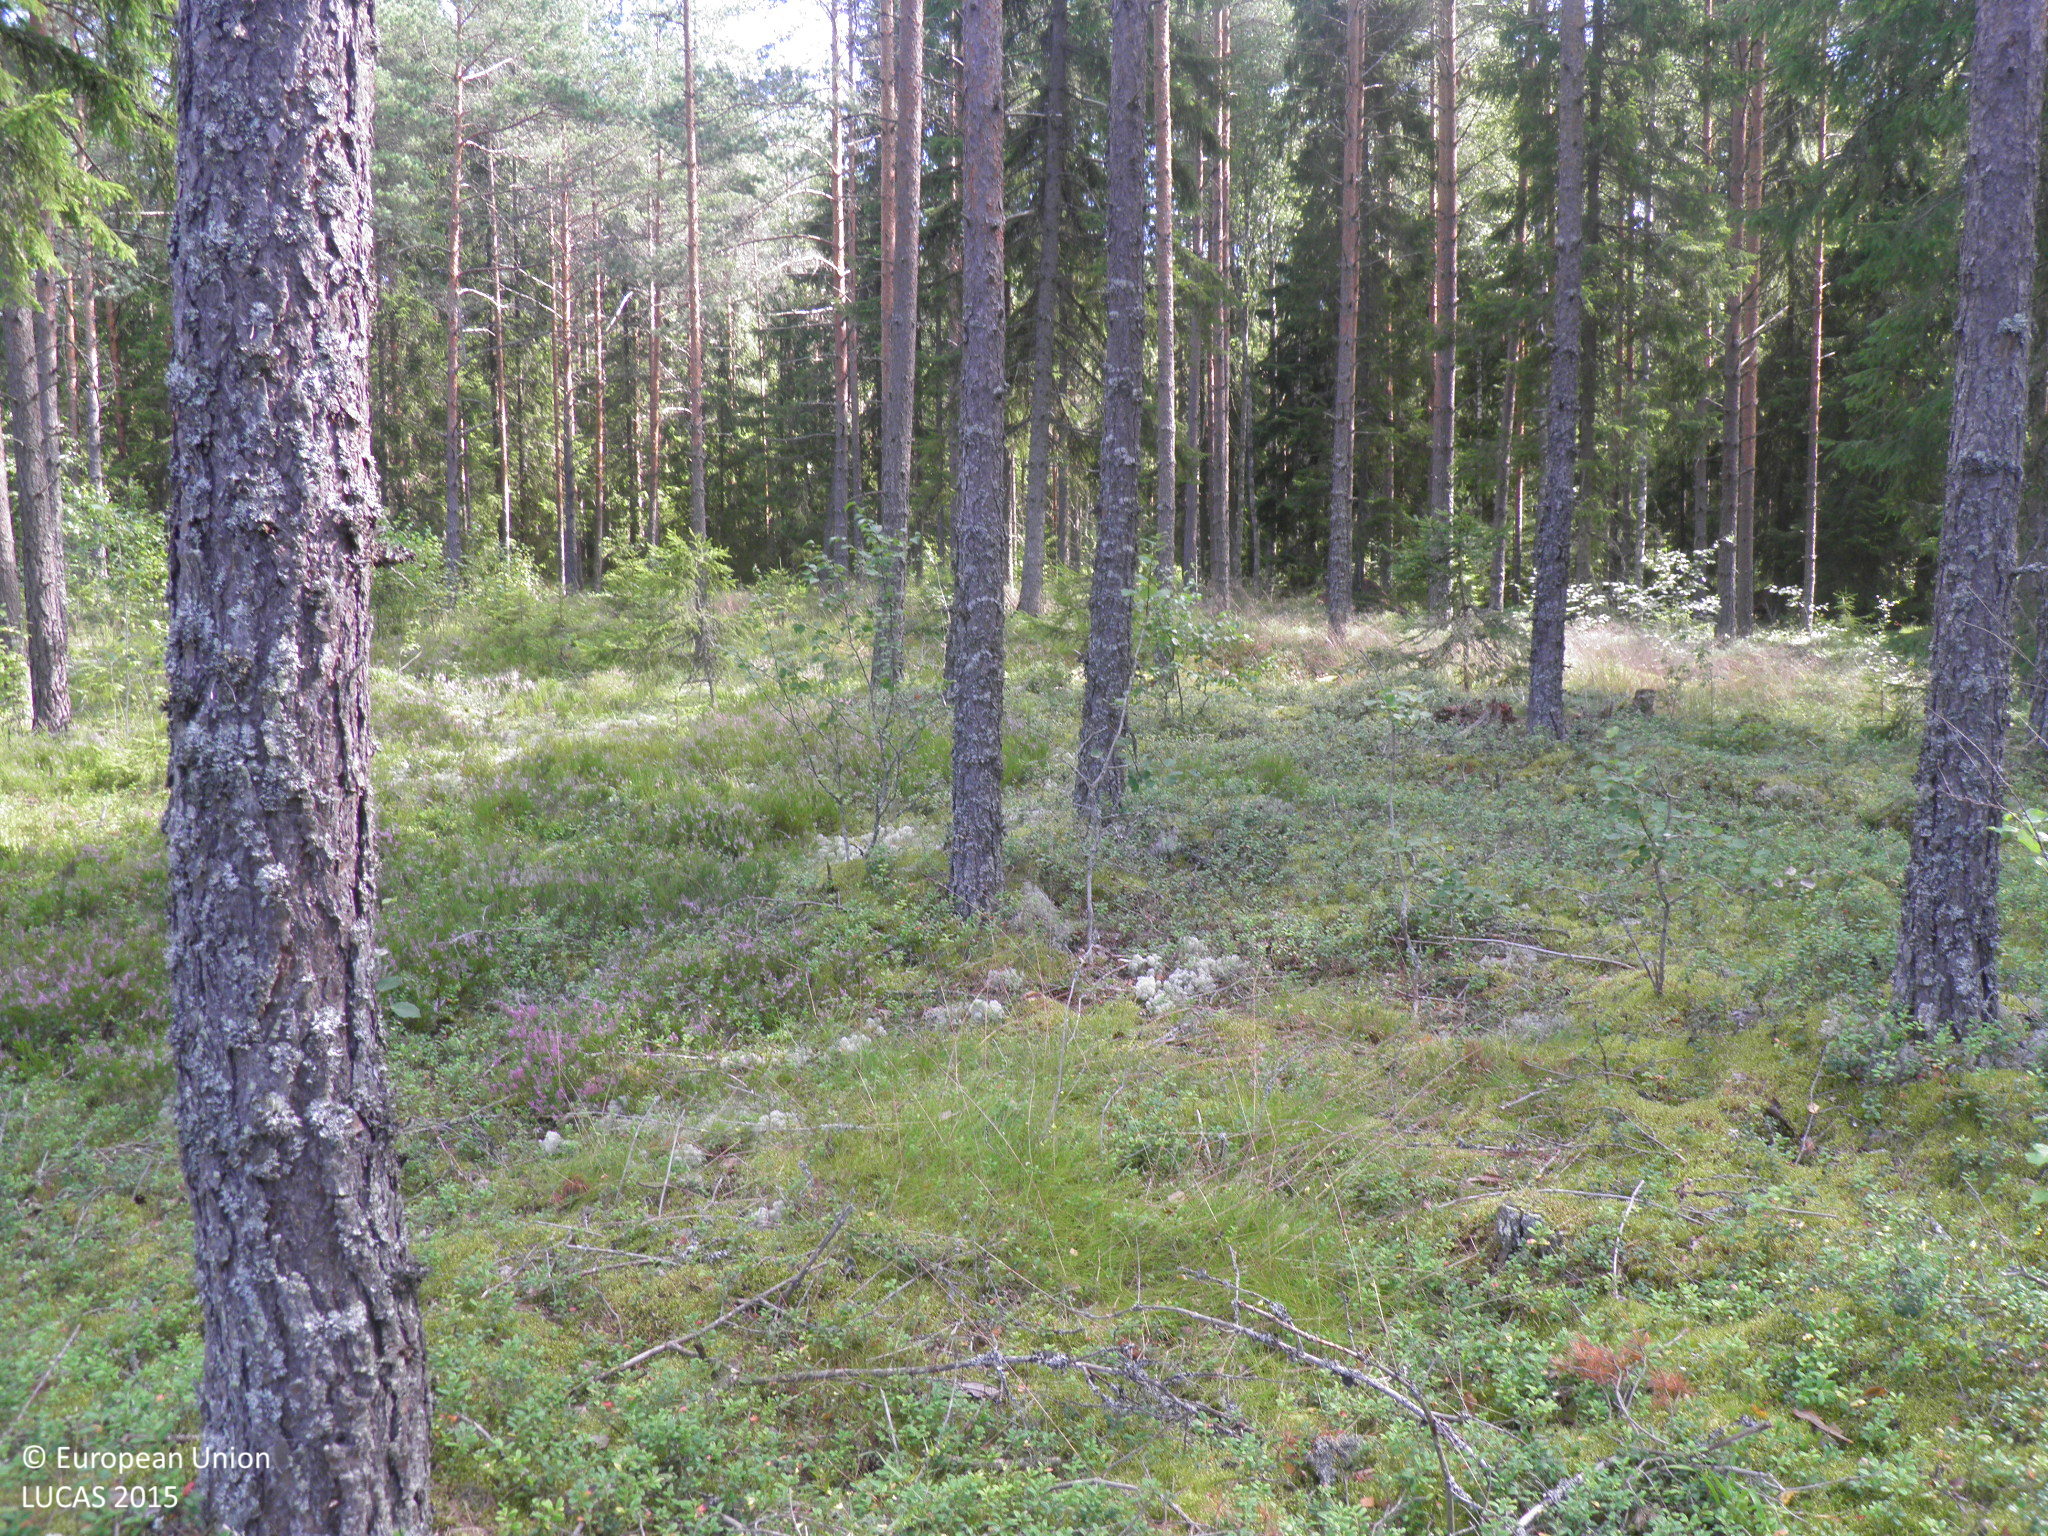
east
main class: Woodland
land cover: Pine dominated coniferous woodland
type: hemiboreal forest and nemoral coniferous forest and mixed broadleaved-coniferous forest
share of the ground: 25 - 50 %
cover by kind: coniferous forest trees 35 %, shrubs 30 %, lichens and mosses 30 %, broadleaved forest trees 5 %
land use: Forestry
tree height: > 5 m
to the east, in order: Pine dominated coniferous woodland; Pine dominated mixed woodland; Ditches and canals; Tracks; Pine dominated mixed woodland; Ditches and canals; Pine dominated mixed woodland
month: August
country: FI
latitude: 61.0286
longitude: 22.0721
